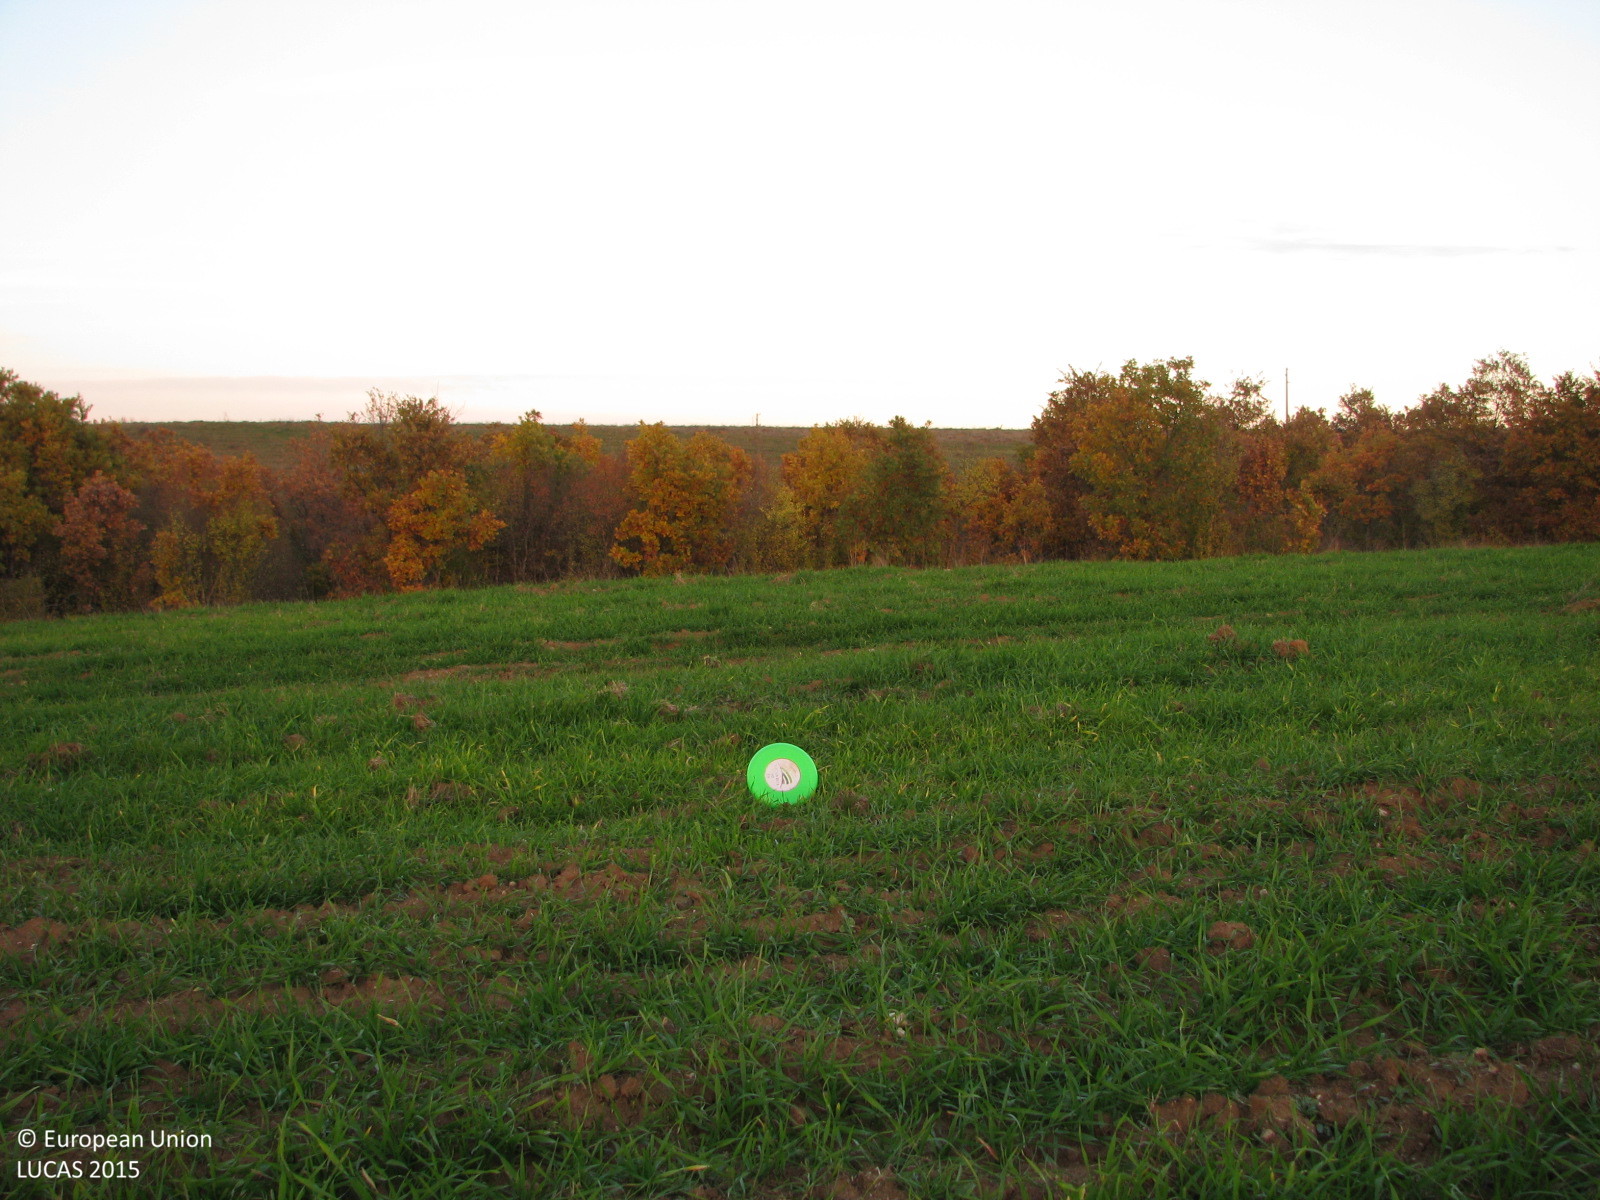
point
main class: Cropland
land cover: Common wheat
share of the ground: 50 - 75 %
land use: Agriculture (excluding fallow land and kitchen gardens)
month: November
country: BG
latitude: 41.9280
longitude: 26.4232
